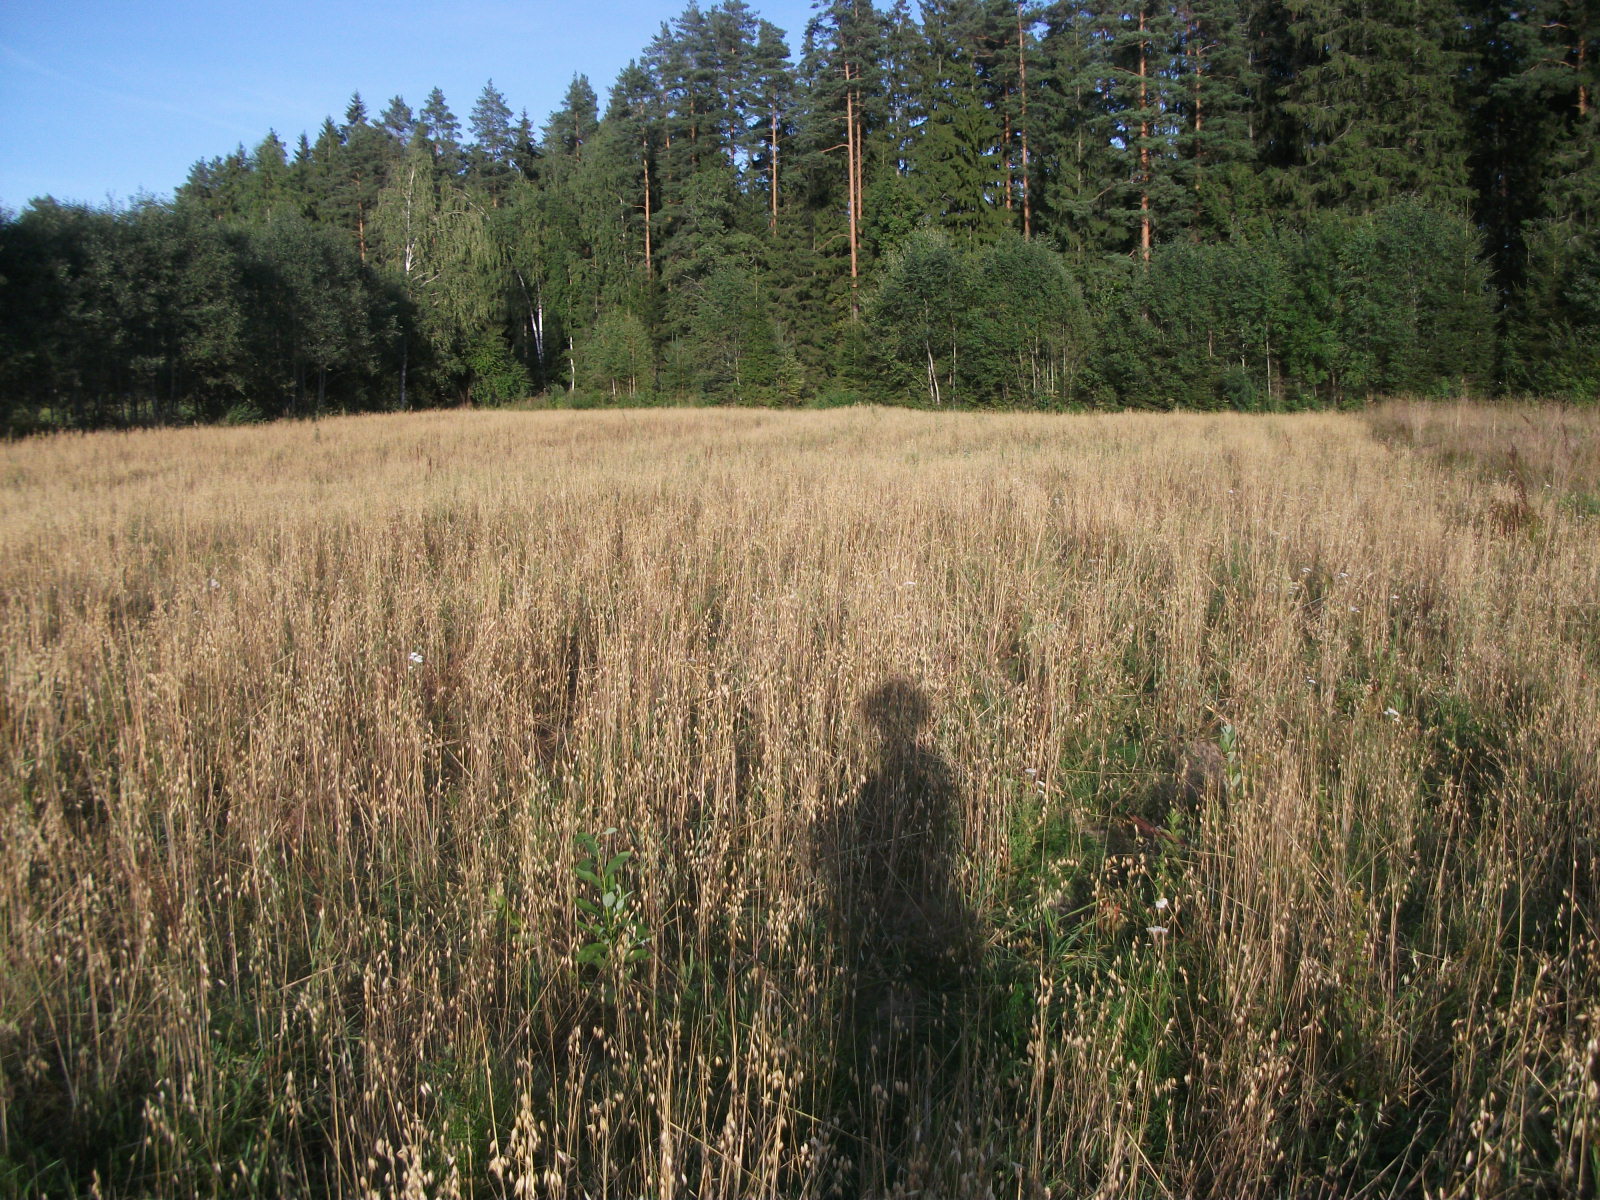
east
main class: Cropland
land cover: Oats
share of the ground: > 75 %
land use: Agriculture (excluding fallow land and kitchen gardens)
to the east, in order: Oats; Abandoned hedges; Grass margins; Paved roads, cycling and walking lanes; Grass margins; Ditches and canals; Other coniferous woodland; Spruce dominated coniferous woodland; Ditches and canals; Shrubland with sparse tree cover; Broadleaved woodland
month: August
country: LV
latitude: 56.3989
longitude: 26.1959
